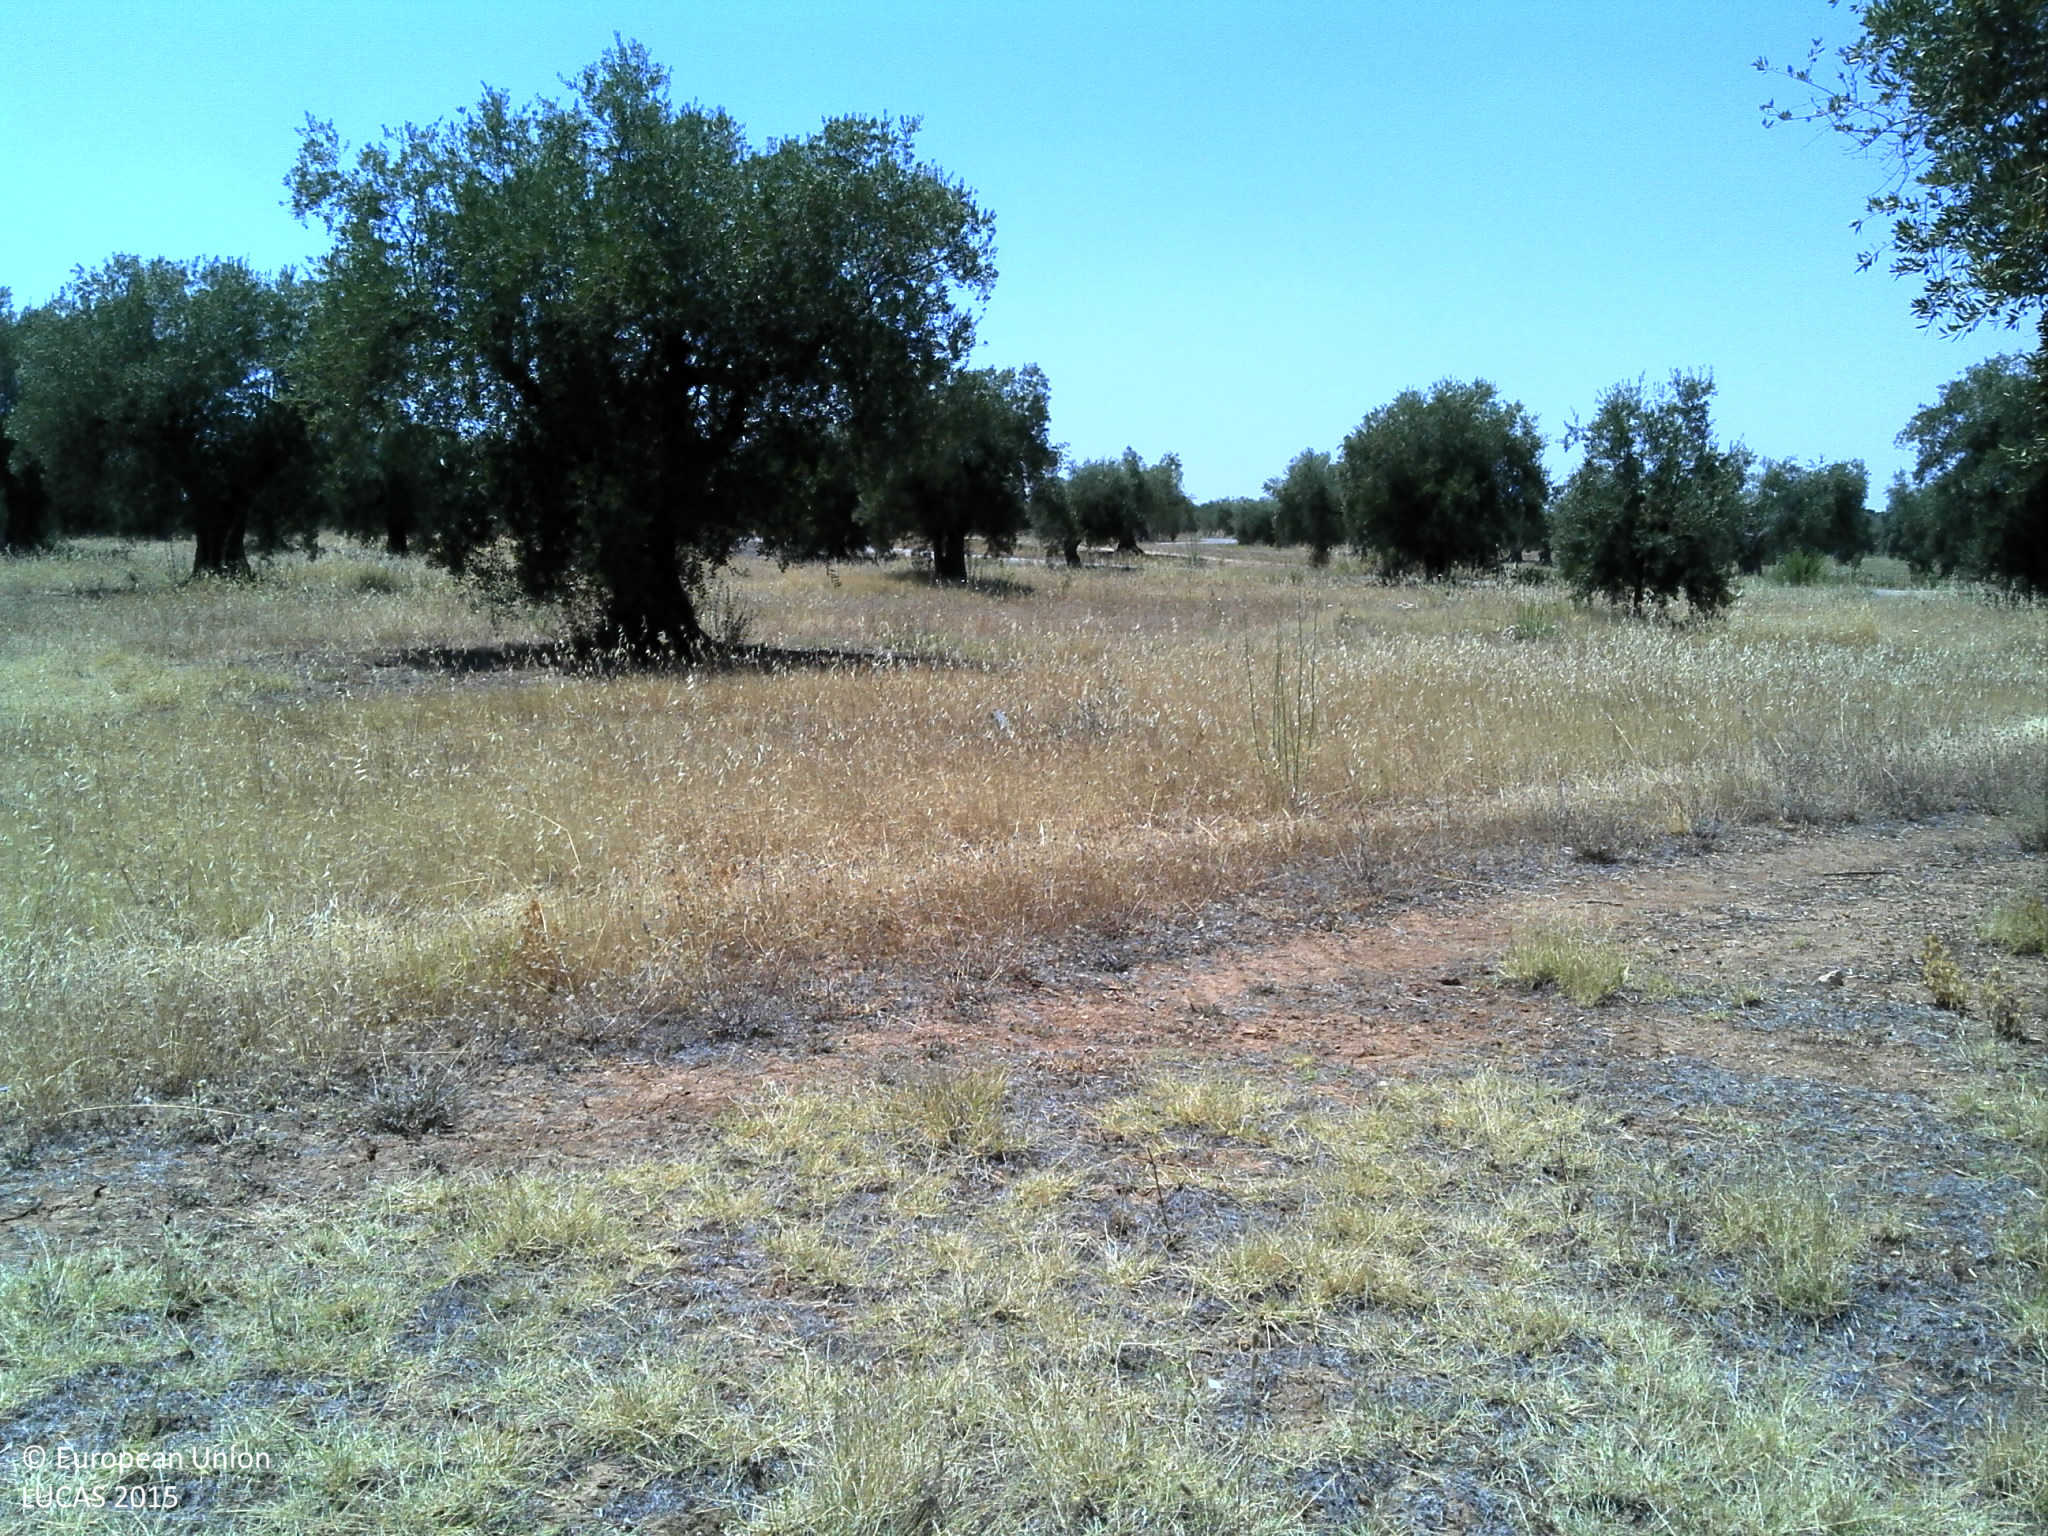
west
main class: Cropland
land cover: Olive groves
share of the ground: 25 - 50 %
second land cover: Grassland without tree/shrub cover
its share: 25 - 50 %
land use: Agriculture (excluding fallow land and kitchen gardens)
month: June
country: PT
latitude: 38.0284
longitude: -7.5304
